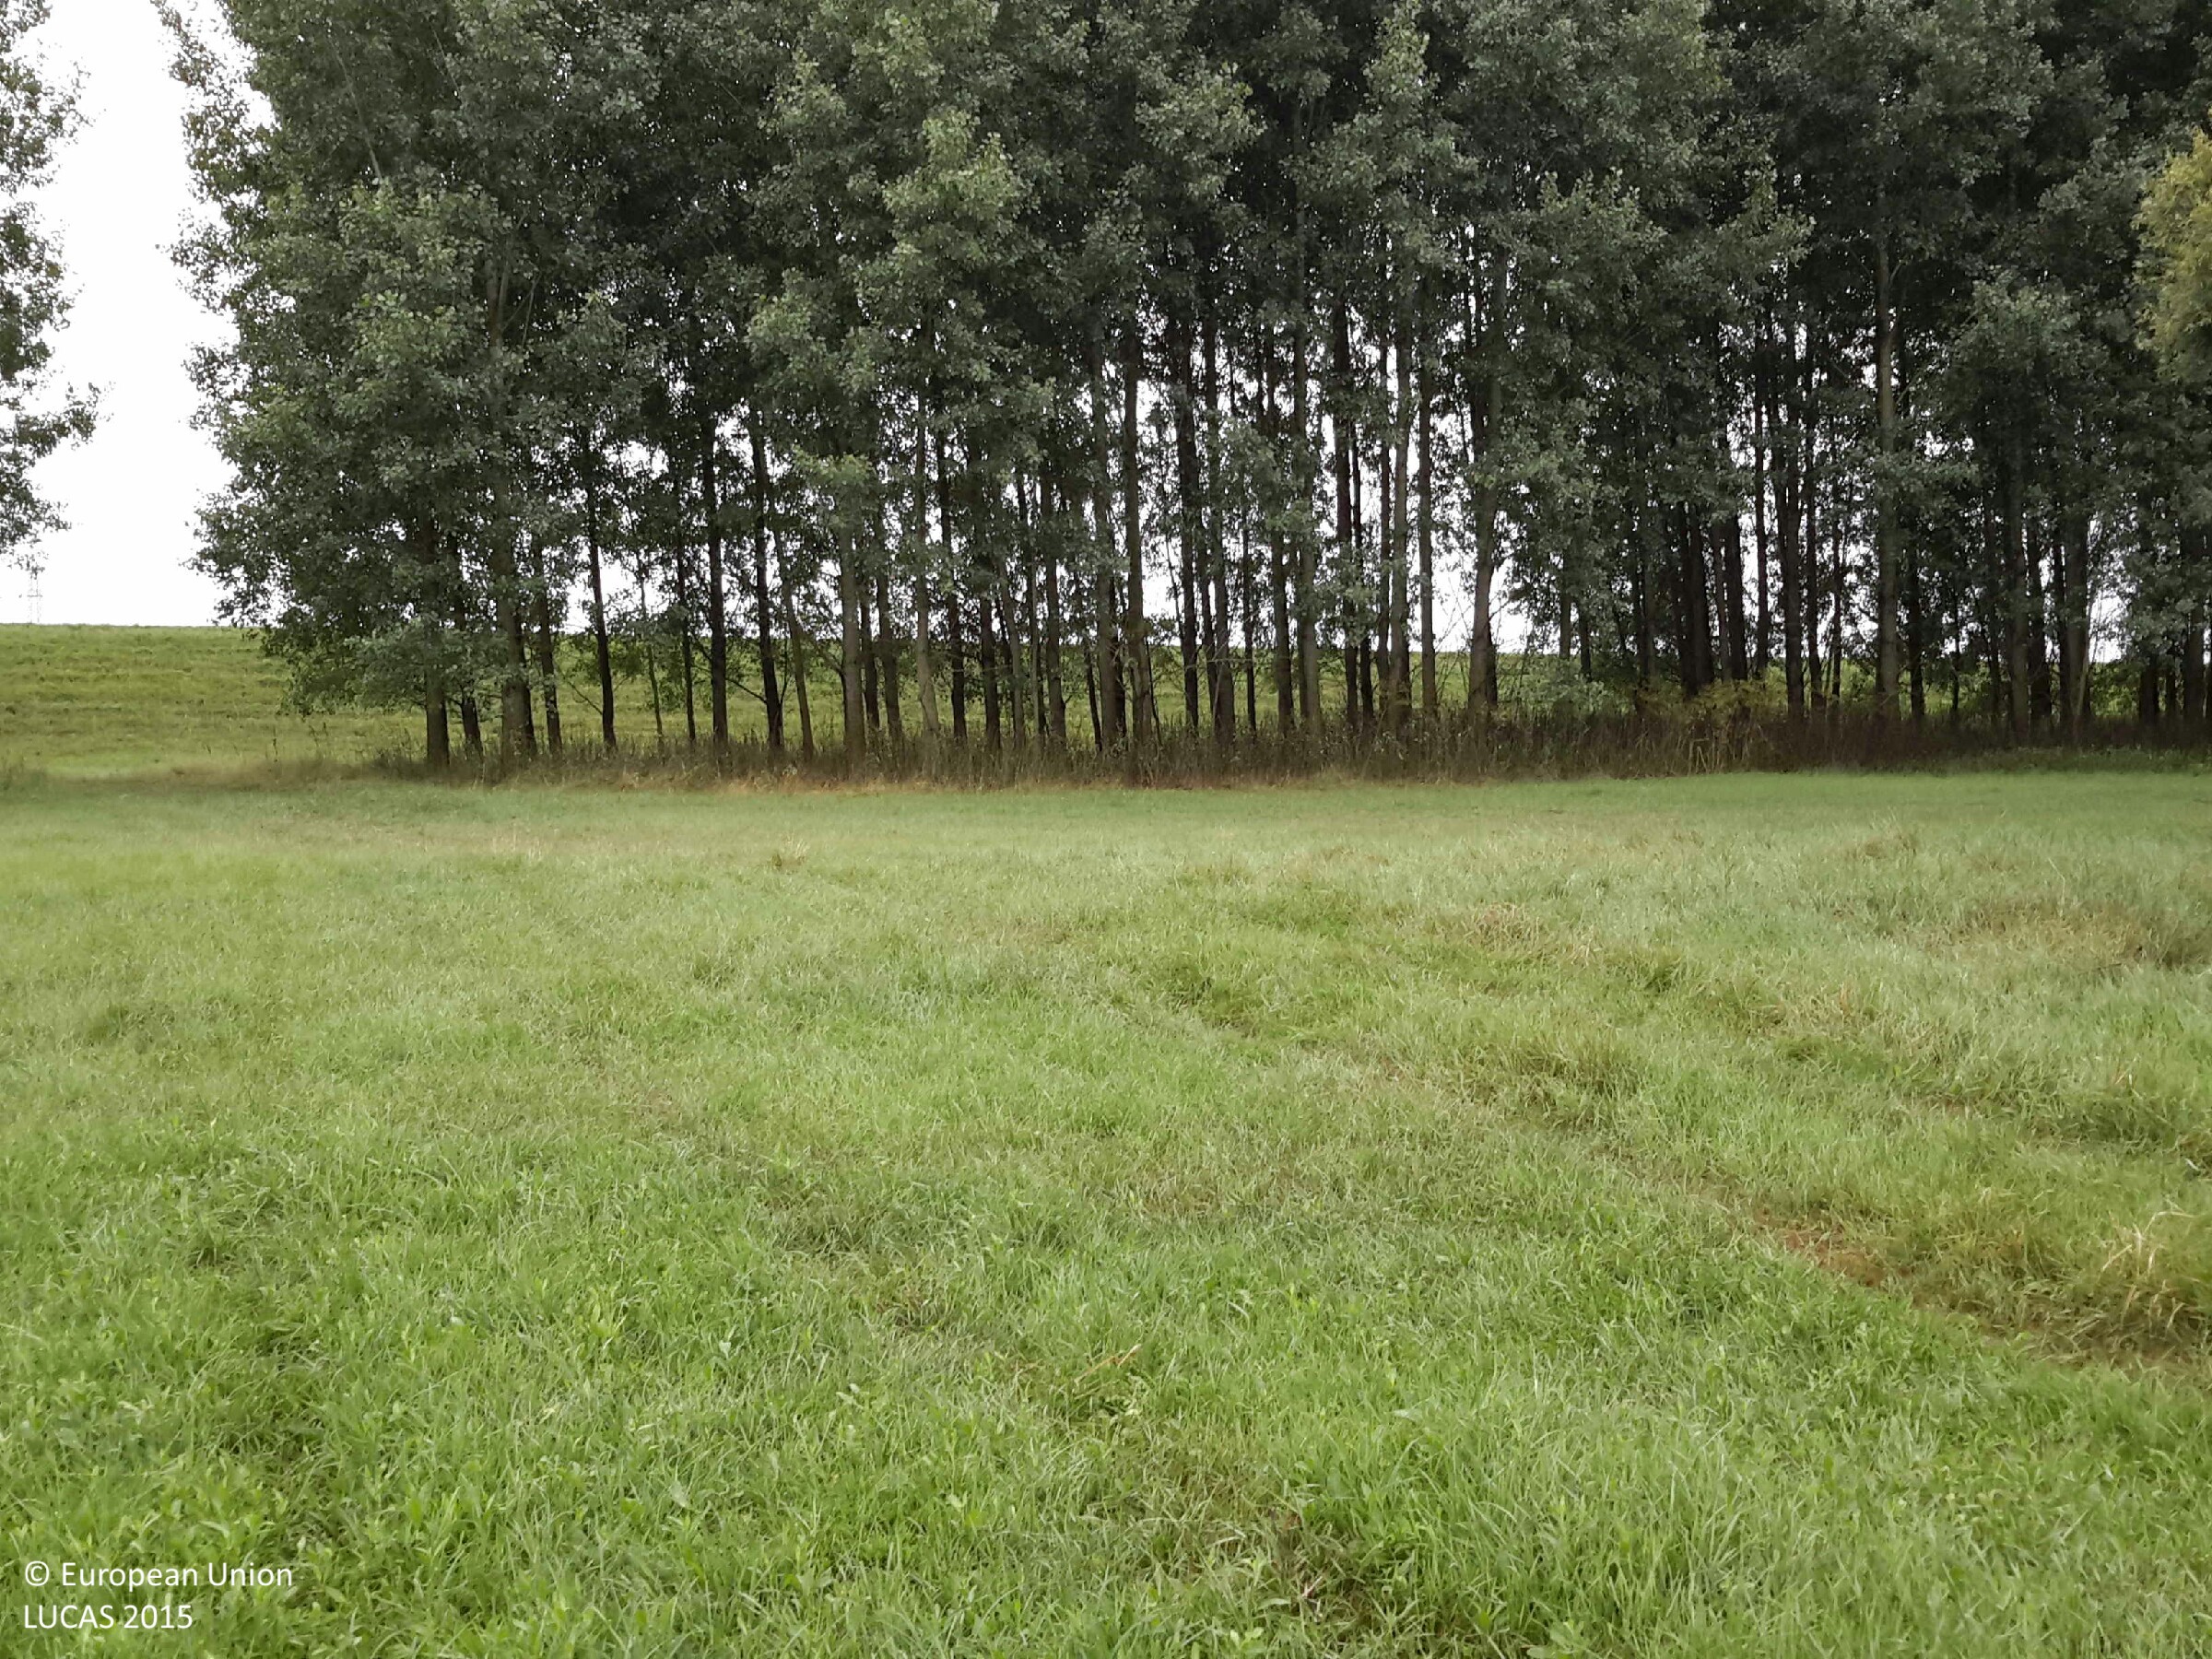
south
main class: Grassland
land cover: Grassland without tree/shrub cover
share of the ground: > 75 %
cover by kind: herbaceous plants 100 %
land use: Agriculture (excluding fallow land and kitchen gardens)
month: July
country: HU
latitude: 47.6245
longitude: 17.5000
